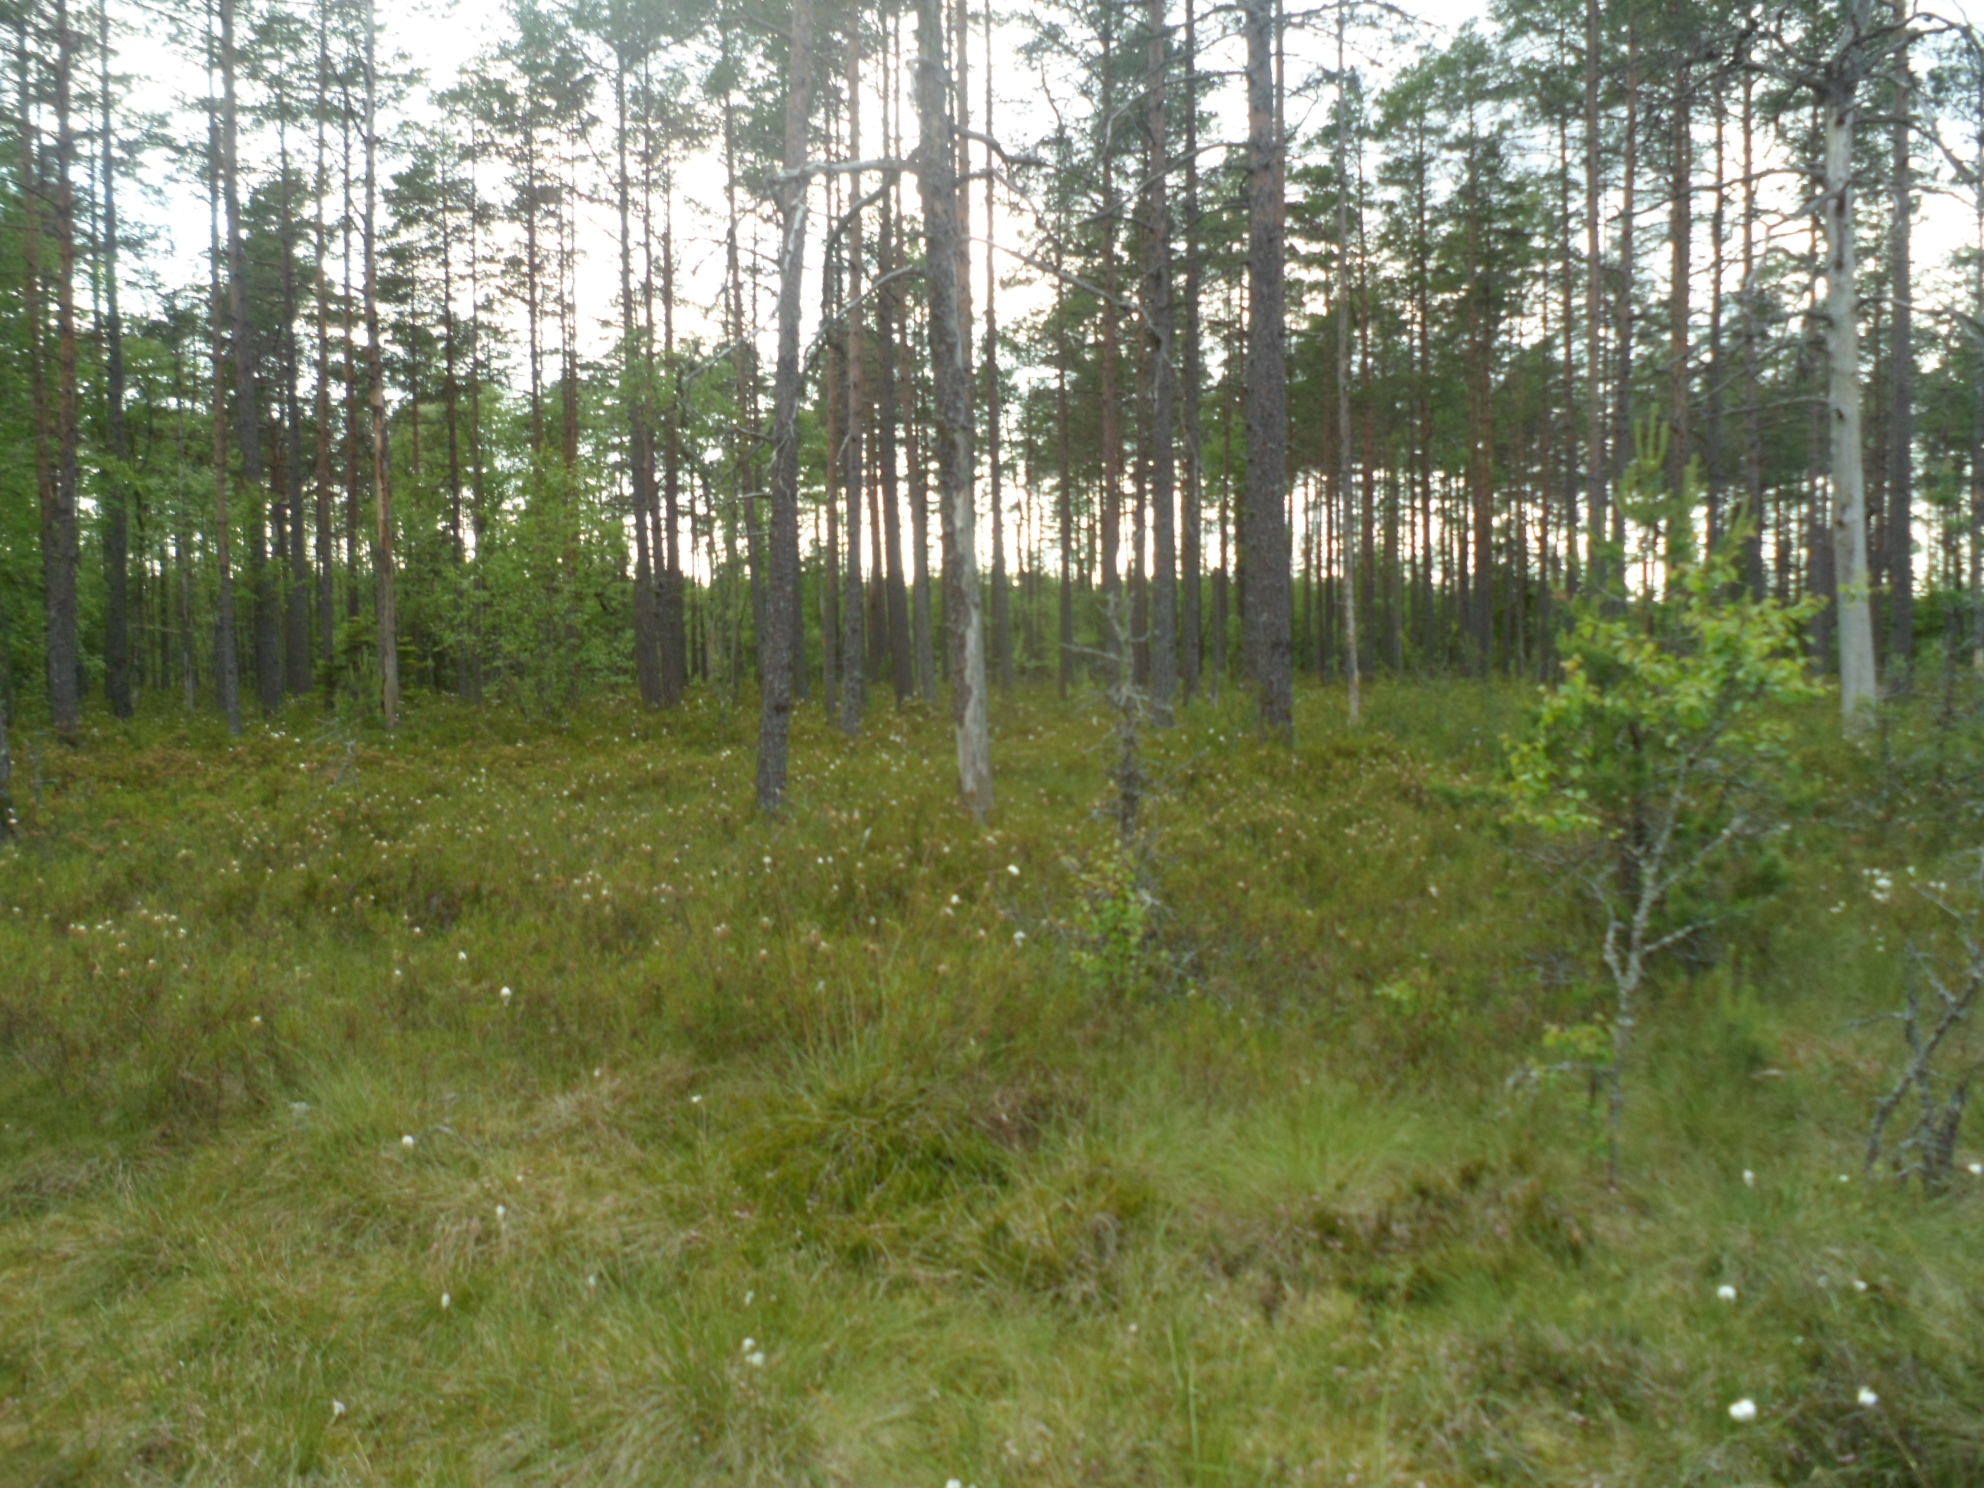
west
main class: Woodland
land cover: Pine dominated mixed woodland
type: boreal forest
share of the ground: 25 - 50 %
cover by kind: coniferous forest trees 25 %, broadleaved forest trees 25 %, herbaceous plants 20 %, lichens and mosses 20 %, shrubs 10 %
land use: Forestry
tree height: > 5 m
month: June
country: SE
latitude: 57.1182
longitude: 15.4310
